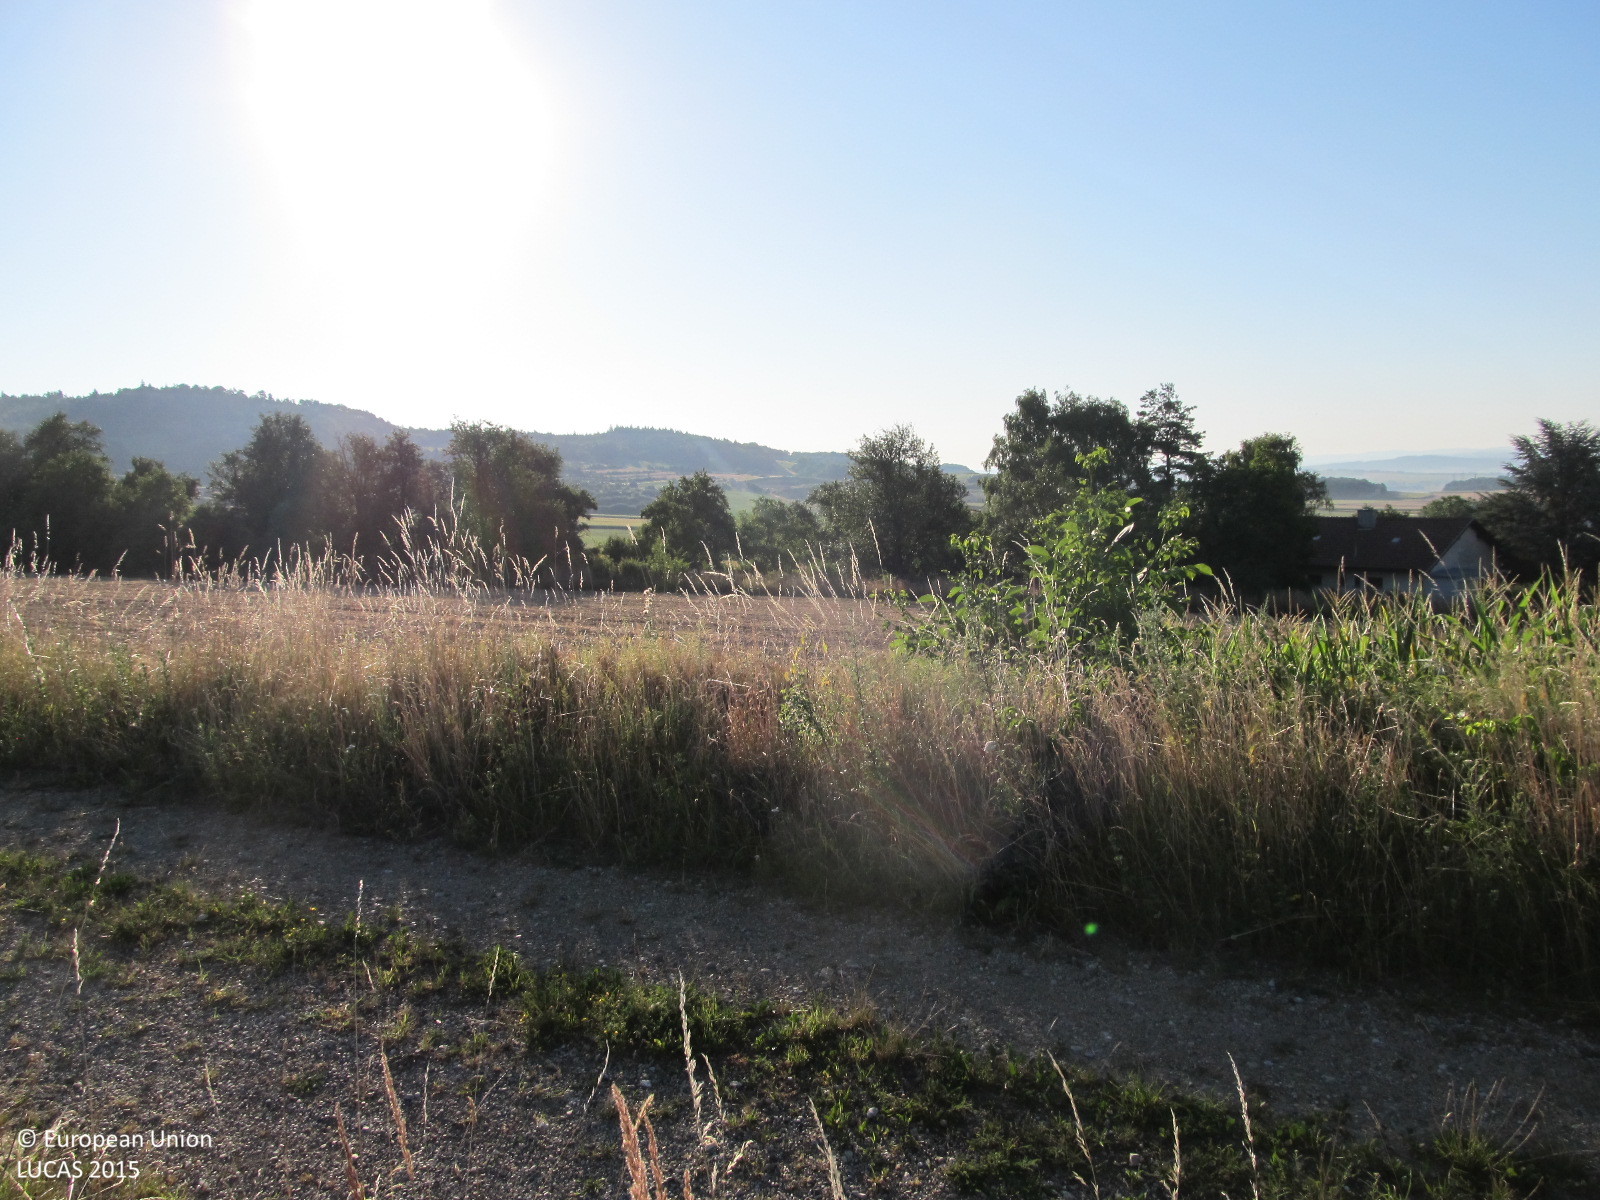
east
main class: Grassland
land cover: Grassland without tree/shrub cover
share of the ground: > 75 %
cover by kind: herbaceous plants 100 %
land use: Agriculture (excluding fallow land and kitchen gardens)
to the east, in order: Grassland without tree/shrub cover; Tracks; Grass margins; Common wheat; Fences; Grassland without tree/shrub cover; Grassland with sparse tree/shrub cover; Paved roads, cycling and walking lanes; Grass margins; Common wheat; Other fruit trees and berries; Sunflower
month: July
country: AT
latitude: 48.2633
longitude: 15.5662
